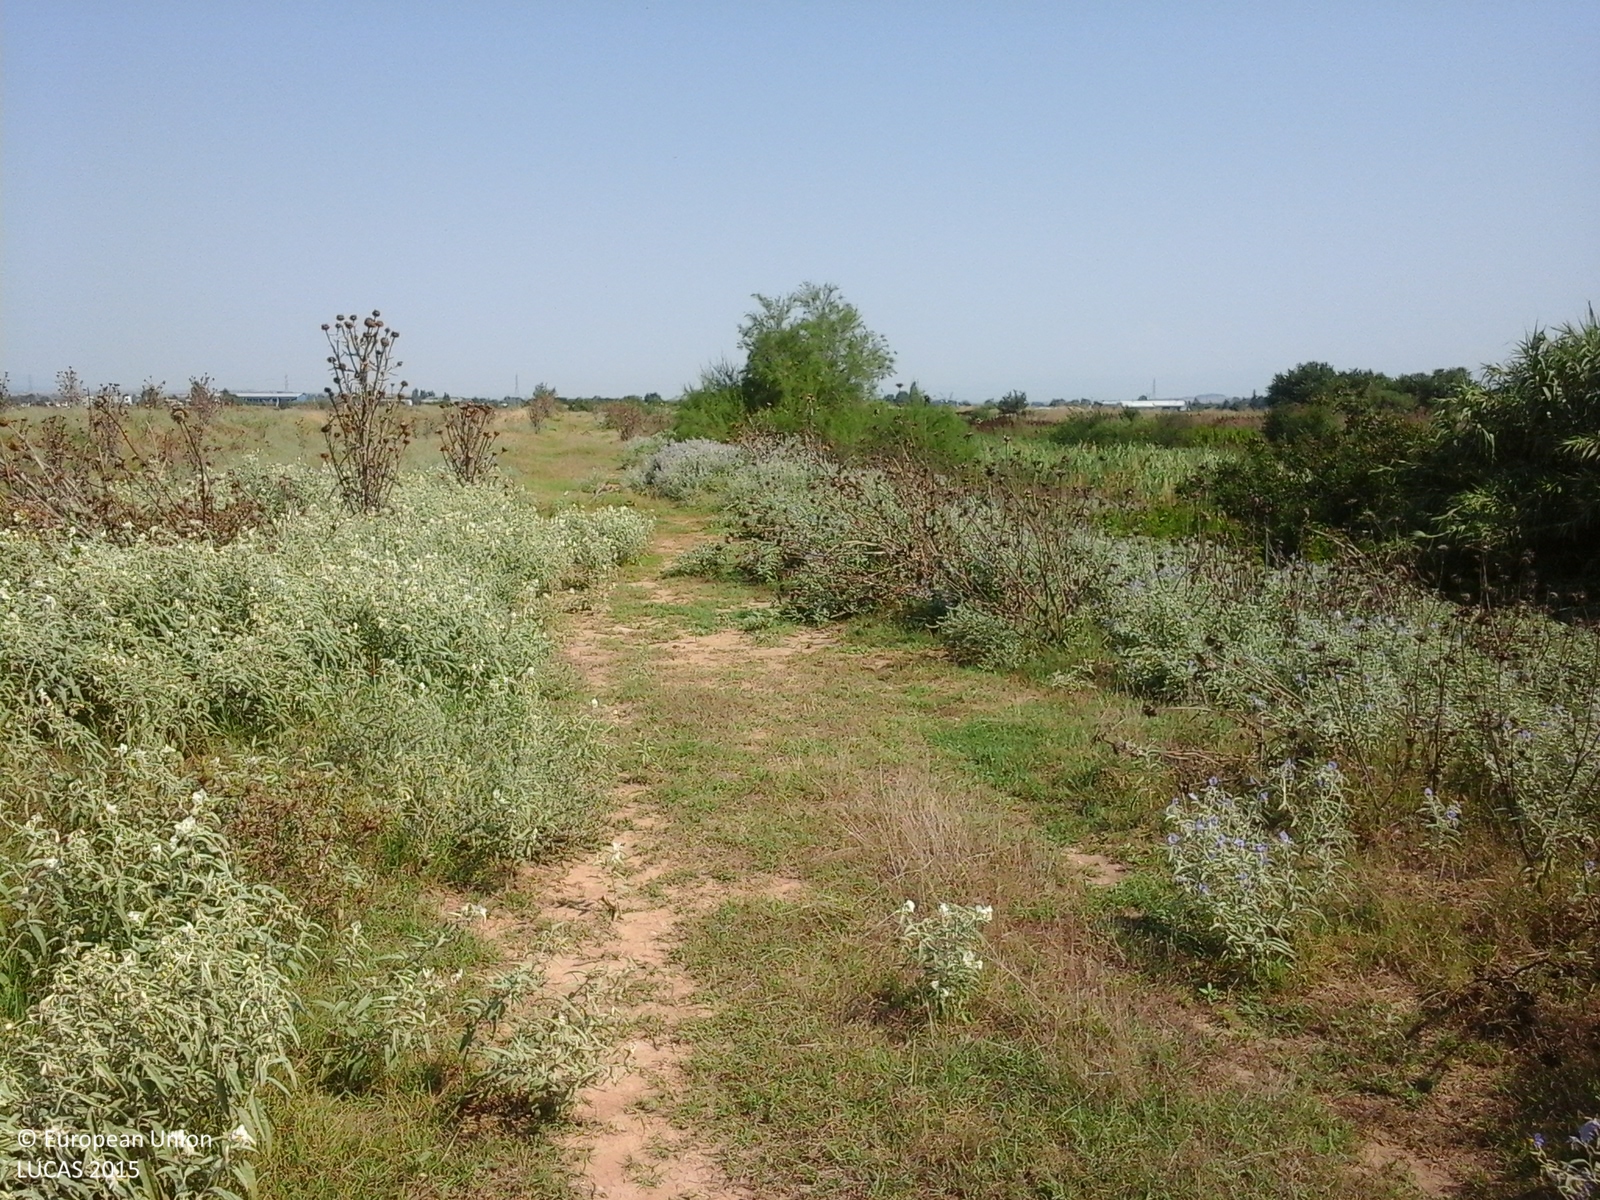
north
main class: Artificial land
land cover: Non built-up linear features
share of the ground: > 75 %
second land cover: Spontaneously vegetated surfaces
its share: > 75 %
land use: Road transport
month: August
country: GR
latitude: 40.7681
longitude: 22.5982
